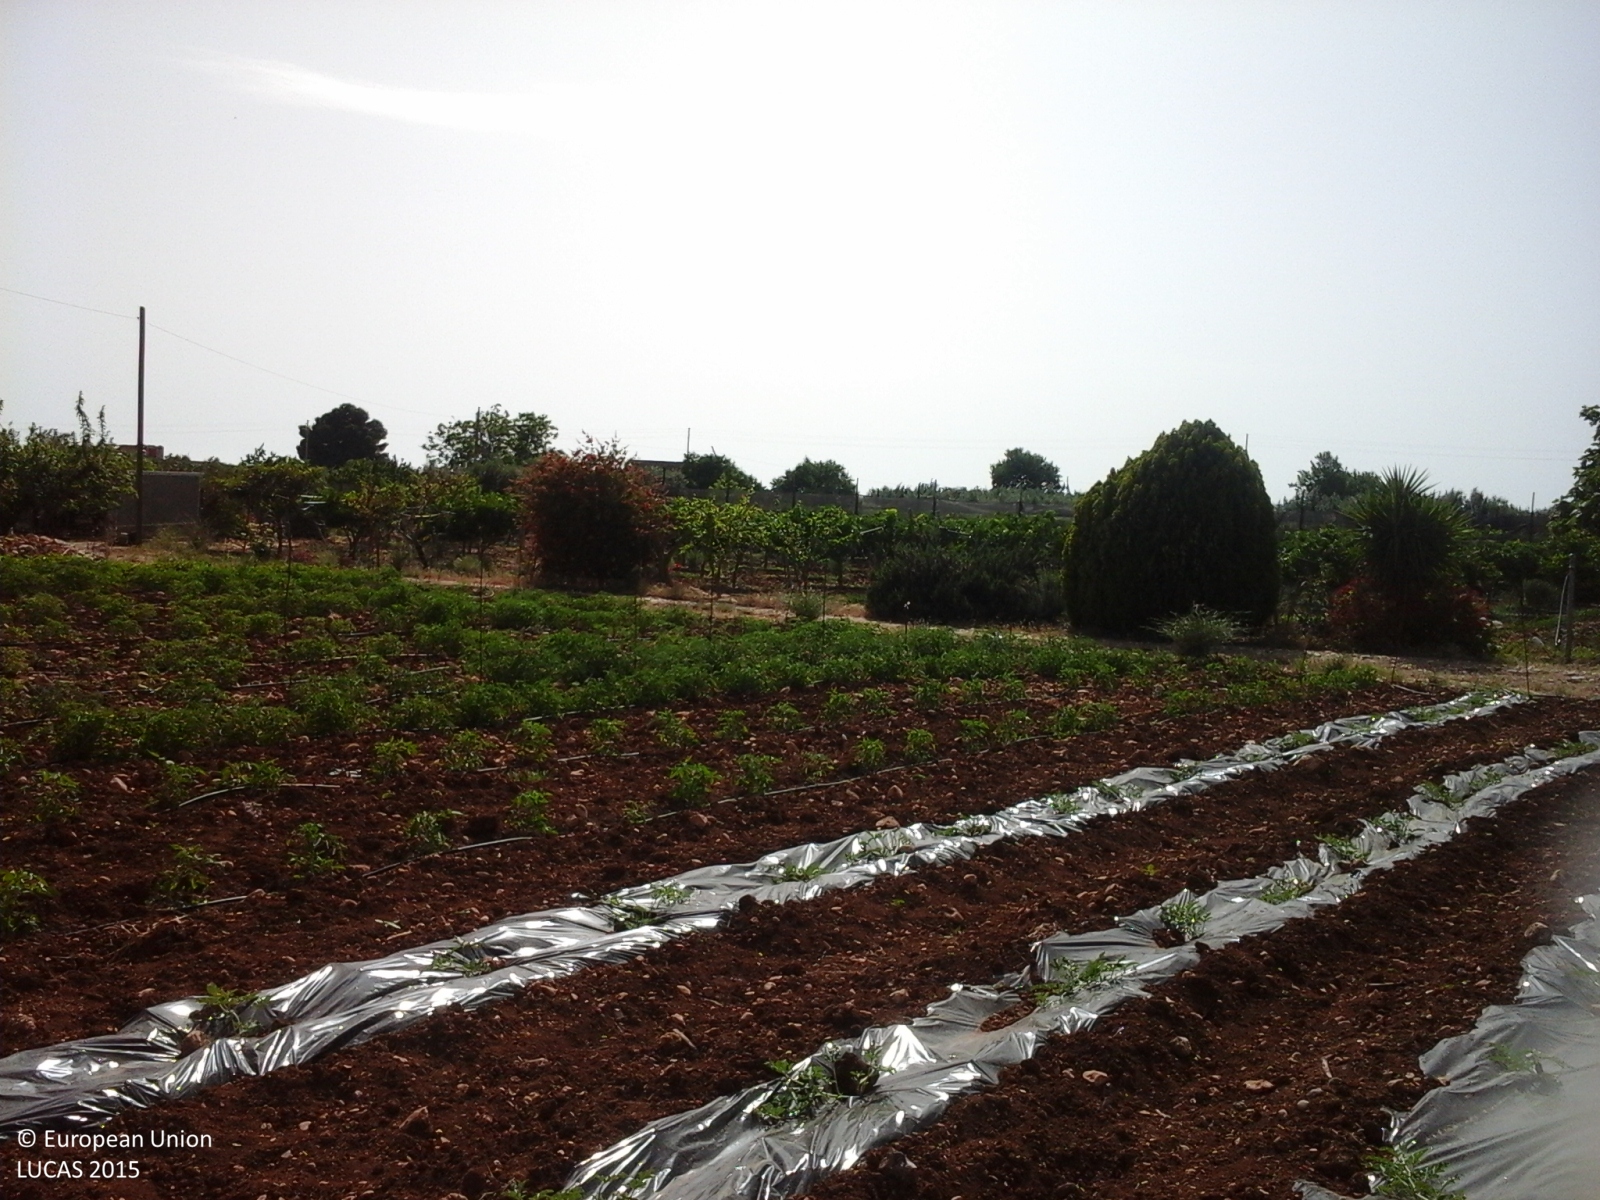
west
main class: Cropland
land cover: Other fresh vegetables
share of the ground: 10 - 25 %
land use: Agriculture (excluding fallow land and kitchen gardens)
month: May
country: IT
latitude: 37.5709
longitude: 13.0676
